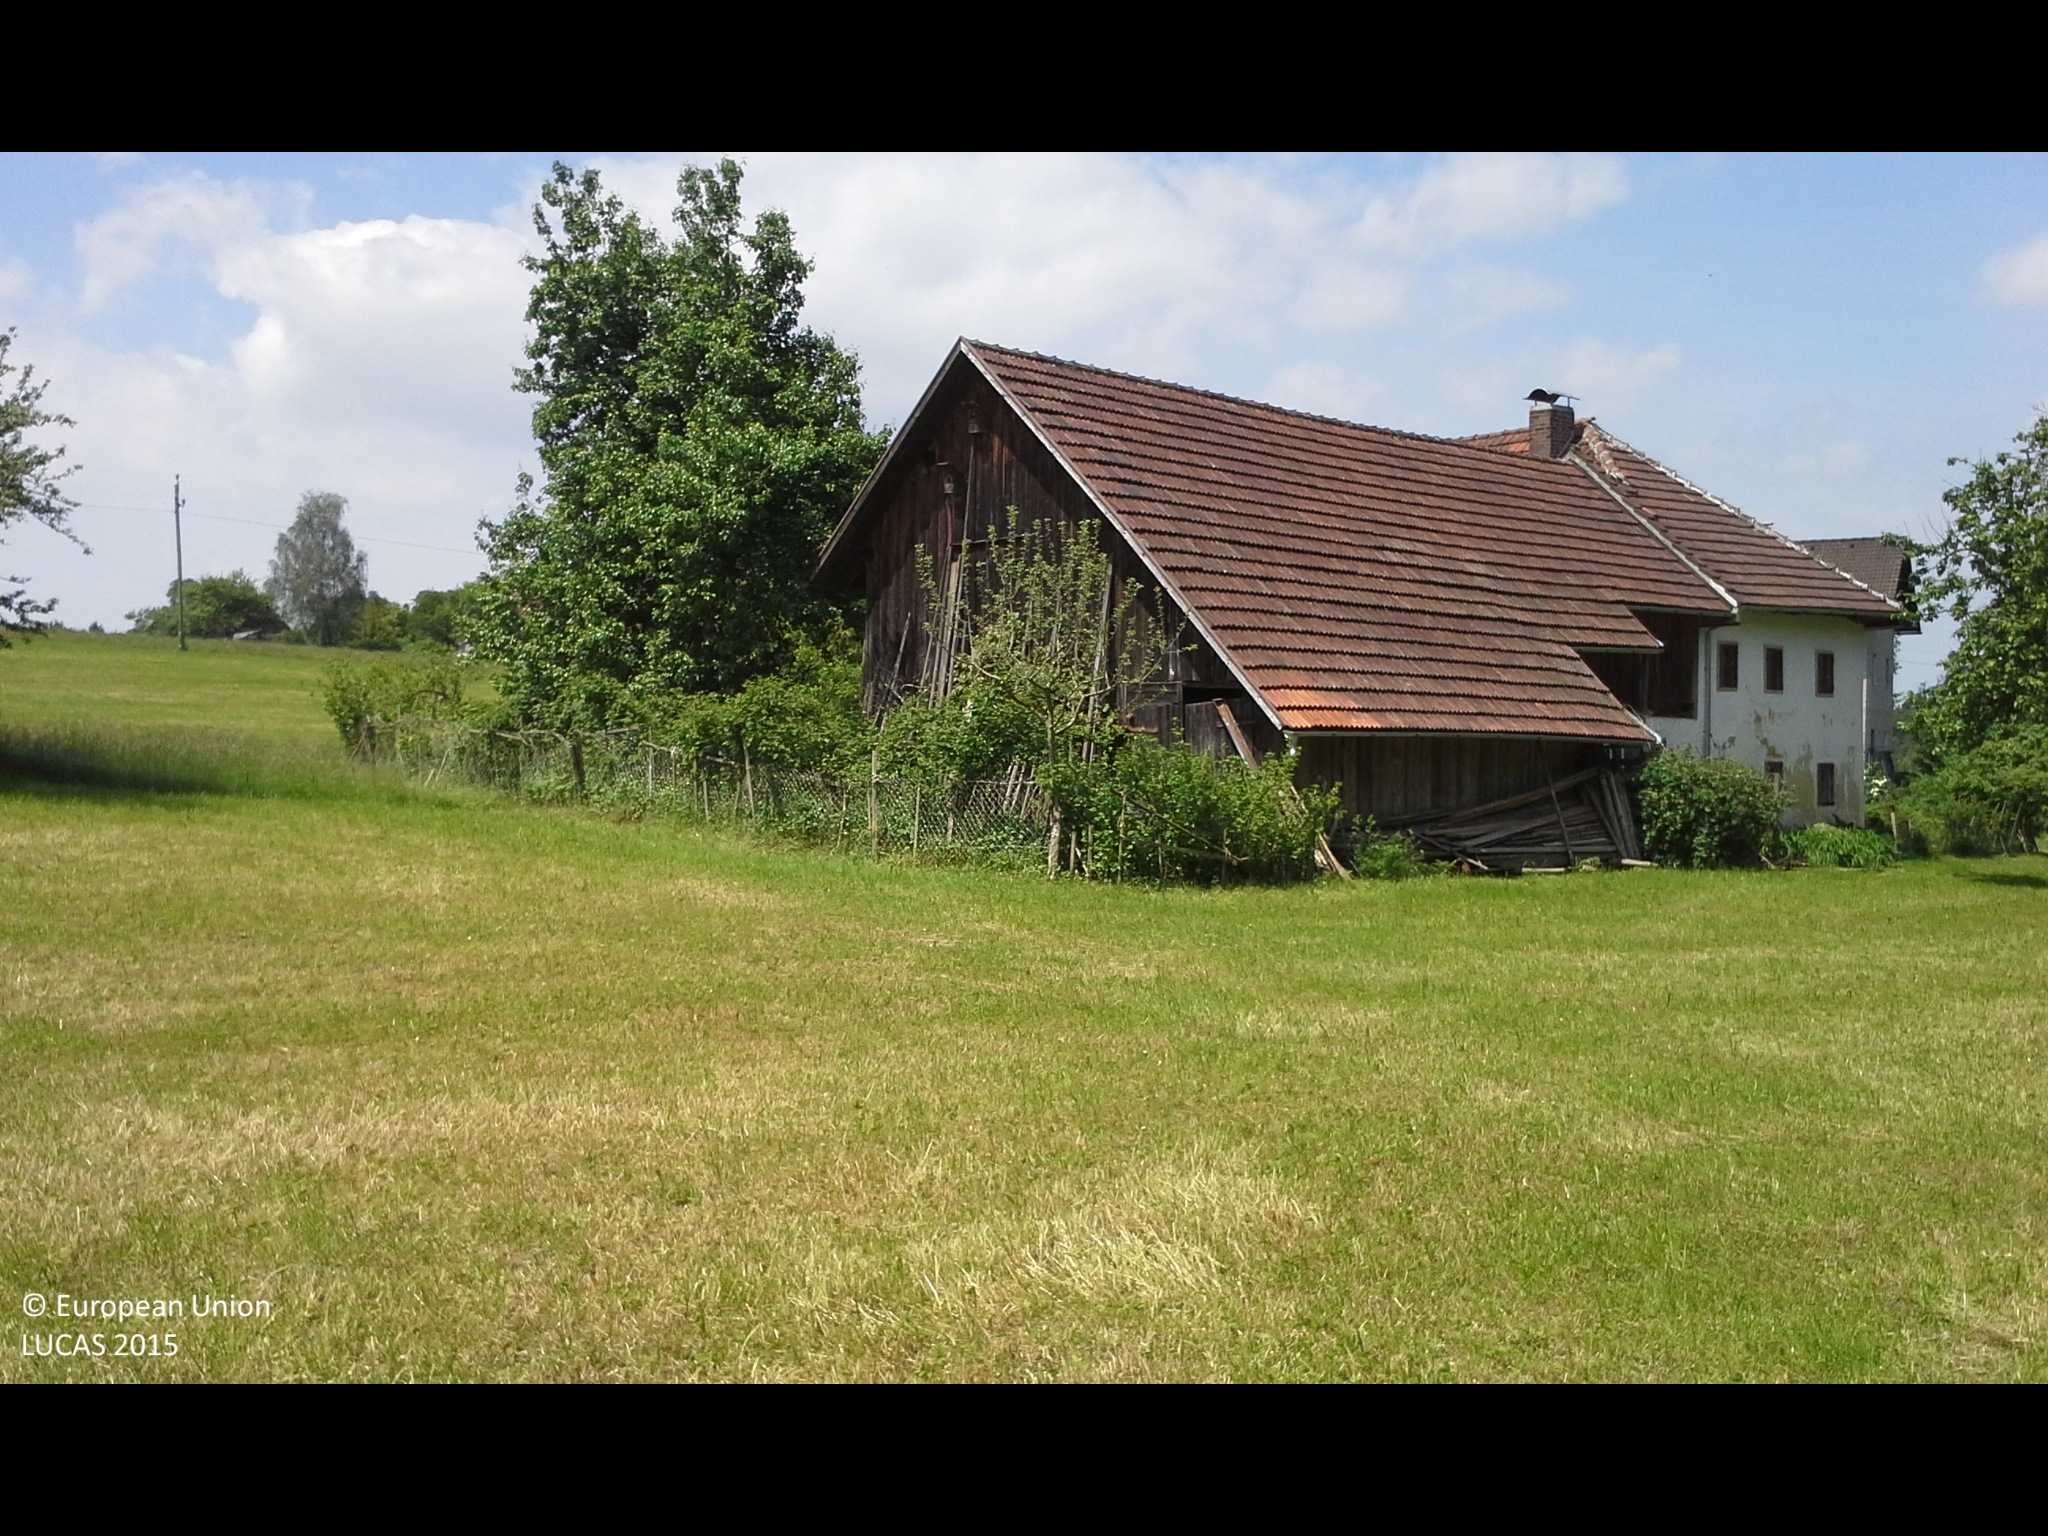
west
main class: Grassland
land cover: Grassland without tree/shrub cover
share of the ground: > 75 %
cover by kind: herbaceous plants 100 %
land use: Agriculture (excluding fallow land and kitchen gardens)
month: May
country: AT
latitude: 47.9806
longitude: 14.2199
